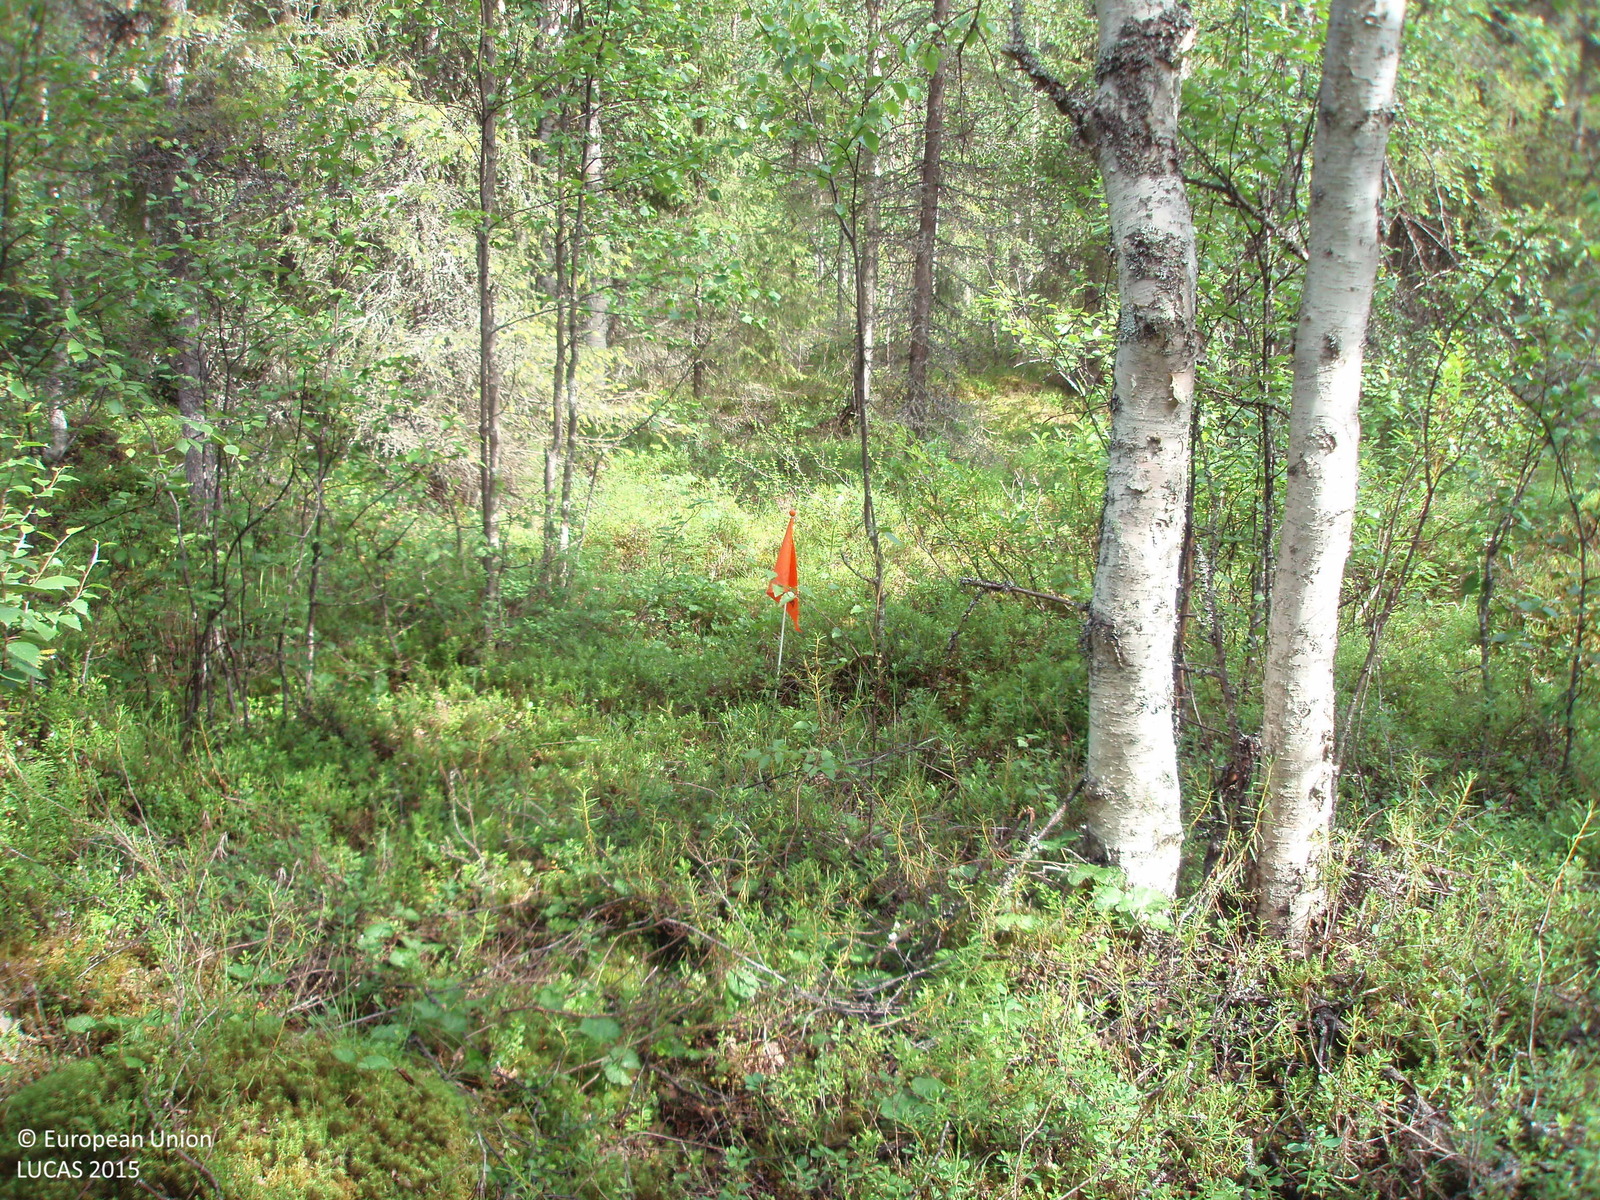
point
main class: Woodland
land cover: Other mixed woodland
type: boreal forest
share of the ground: > 75 %
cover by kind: coniferous forest trees 45 %, broadleaved forest trees 40 %, shrubs 15 %
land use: Forestry
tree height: > 5 m
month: July
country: FI
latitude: 66.9322
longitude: 28.5987
